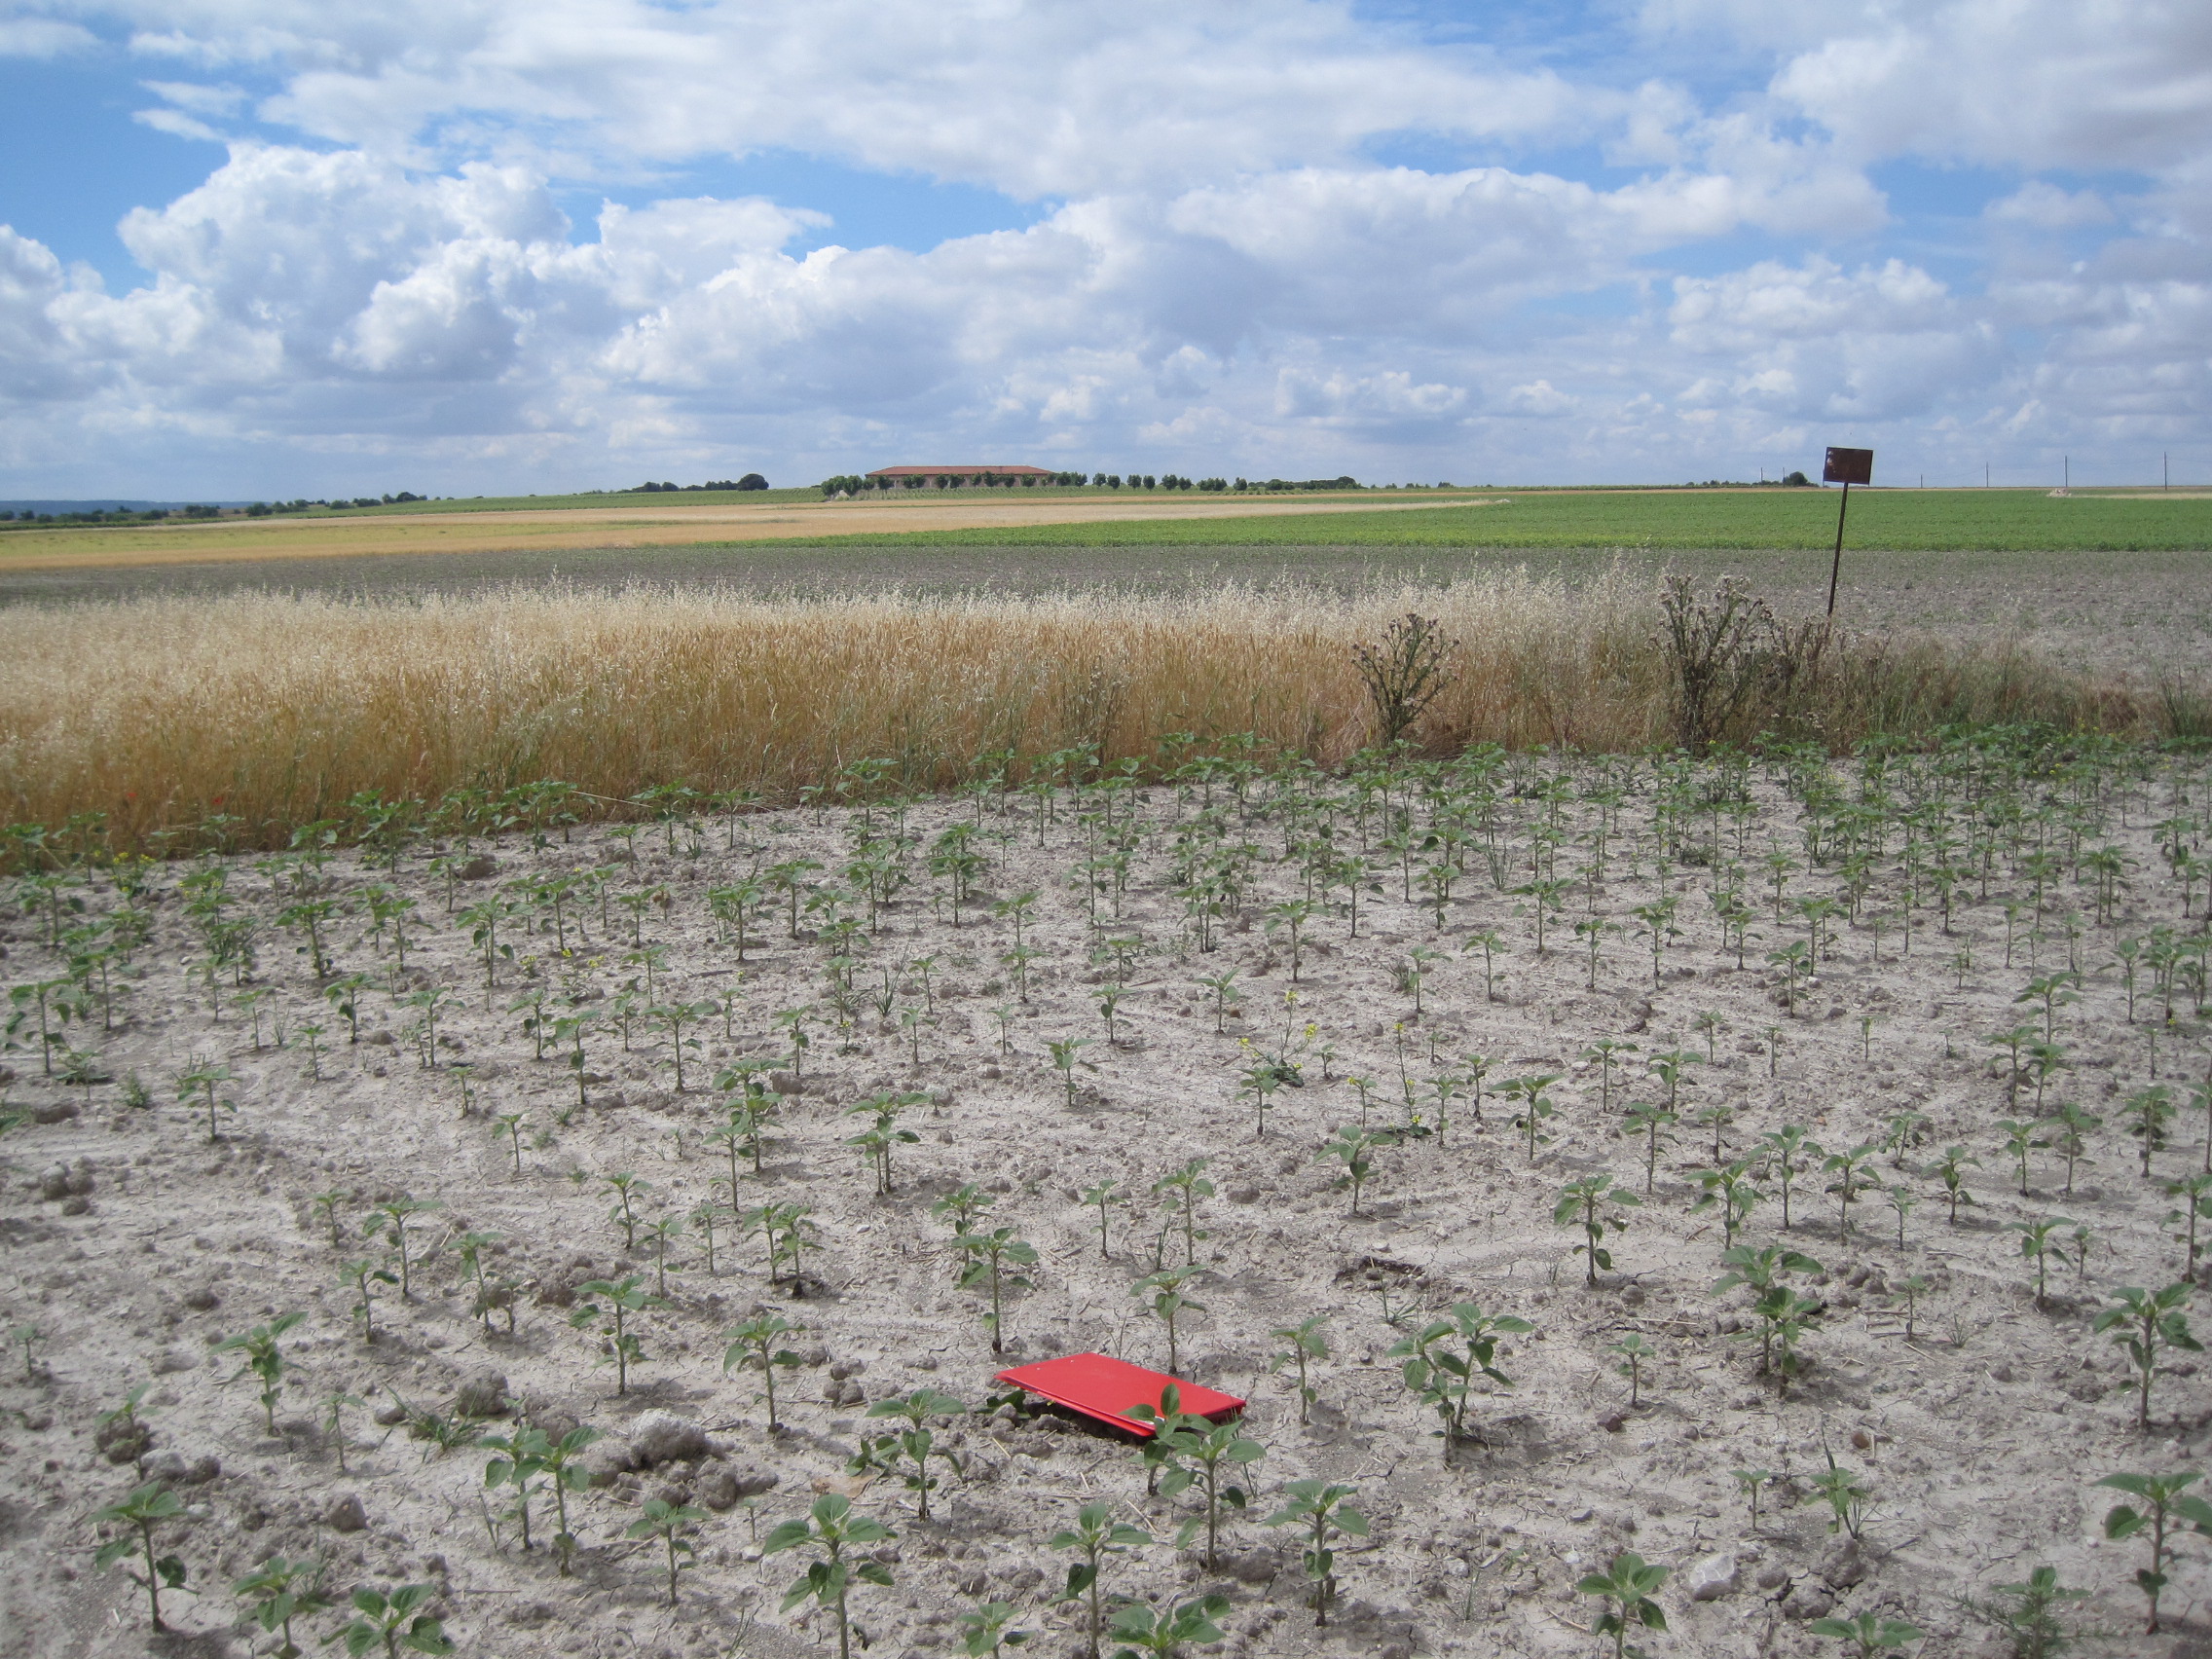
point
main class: Cropland
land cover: Sunflower
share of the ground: 25 - 50 %
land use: Agriculture (excluding fallow land and kitchen gardens)
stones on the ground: < 10 %
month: June
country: ES
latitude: 41.7959
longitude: -4.6921
